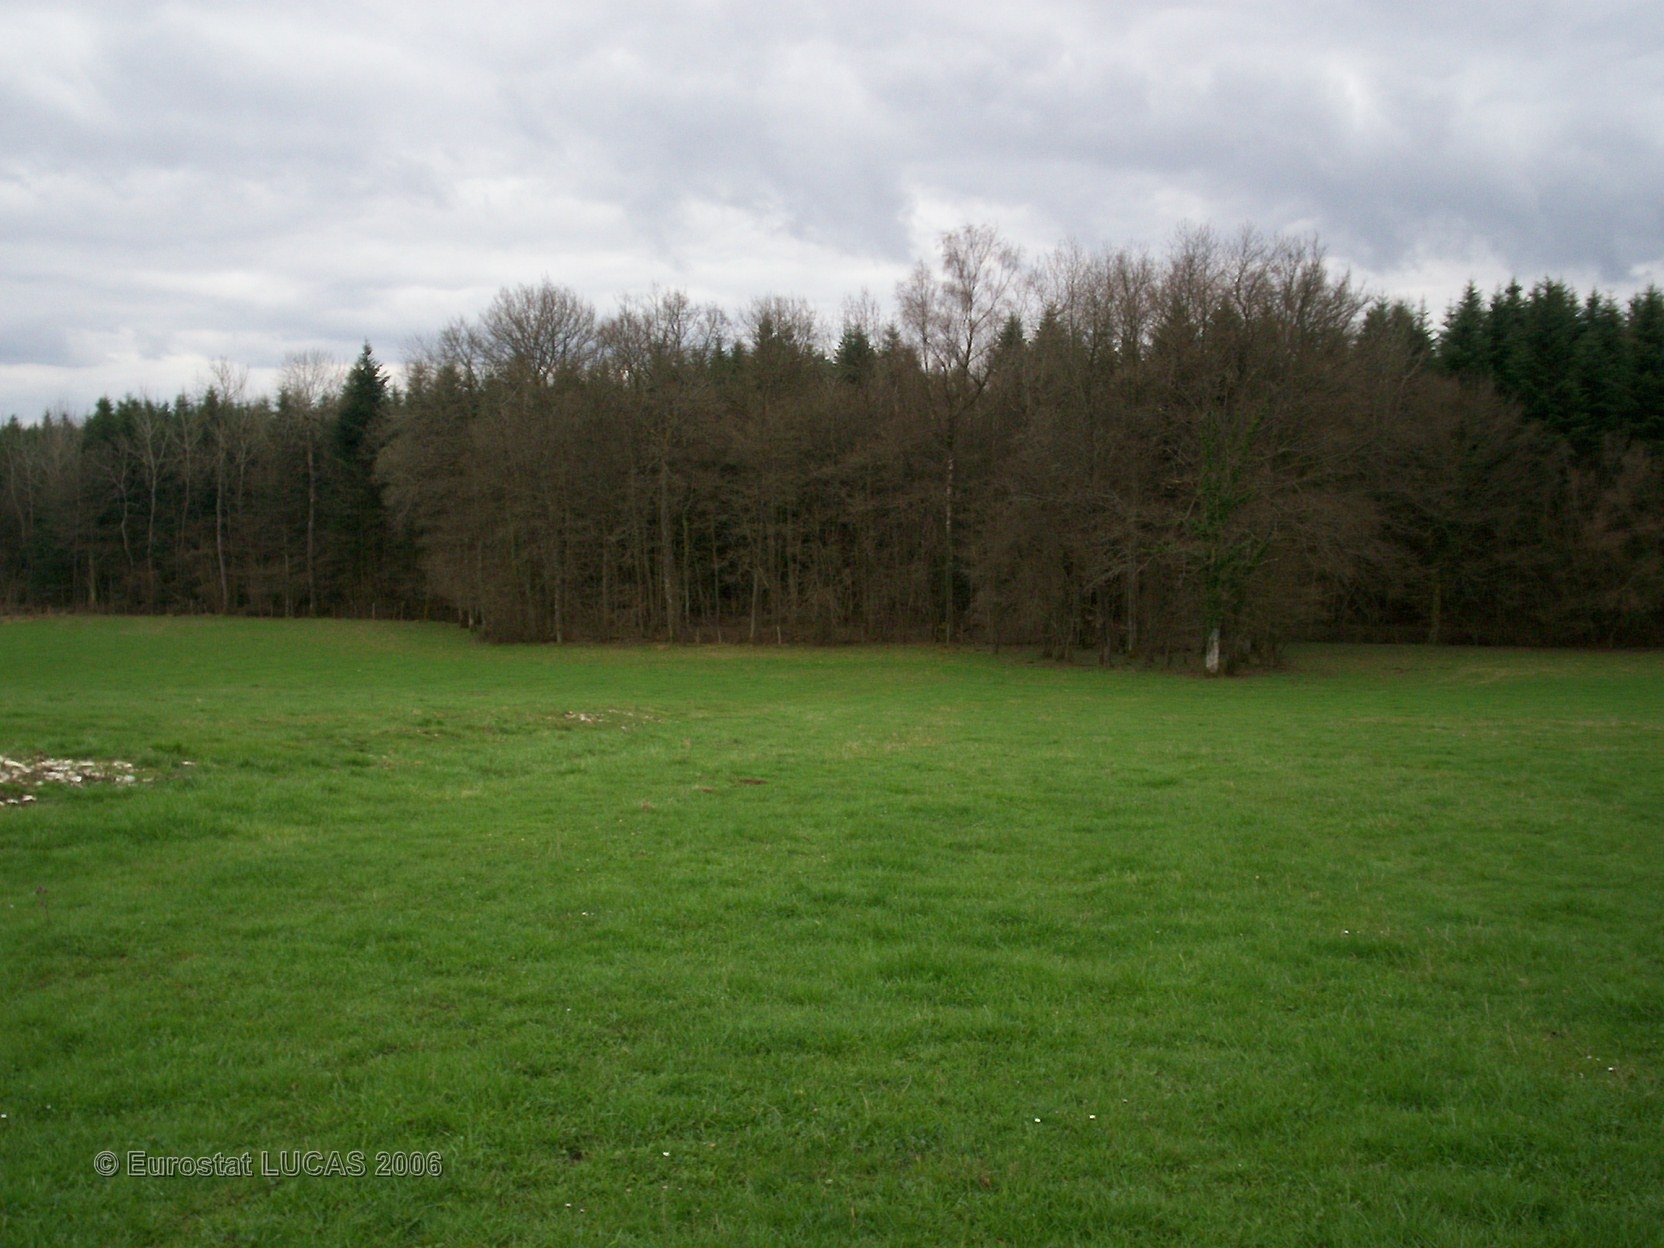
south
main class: Grassland
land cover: Grassland without tree/shrub cover
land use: Agriculture (excluding fallow land and kitchen gardens)
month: April
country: FR
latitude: 47.5647
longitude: 6.7984
